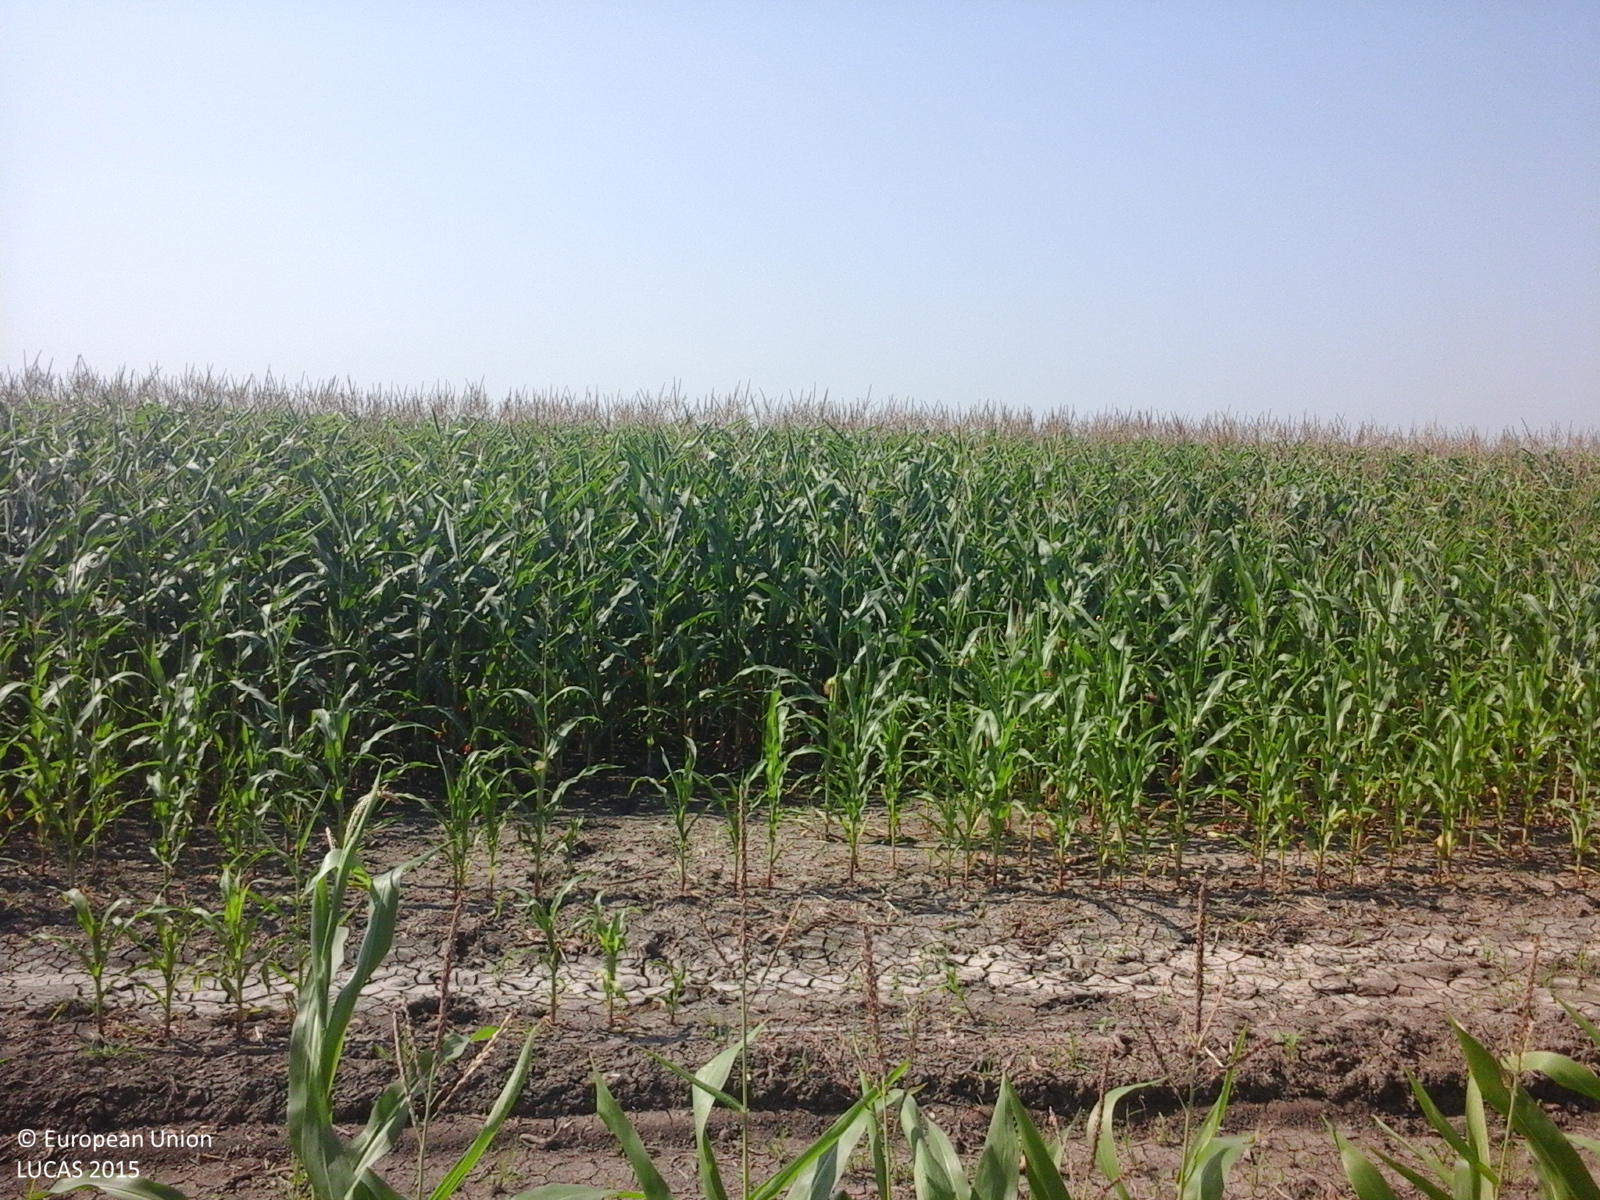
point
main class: Cropland
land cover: Maize
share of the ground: > 75 %
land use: Agriculture (excluding fallow land and kitchen gardens)
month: August
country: RO
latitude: 45.1690
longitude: 28.0430
